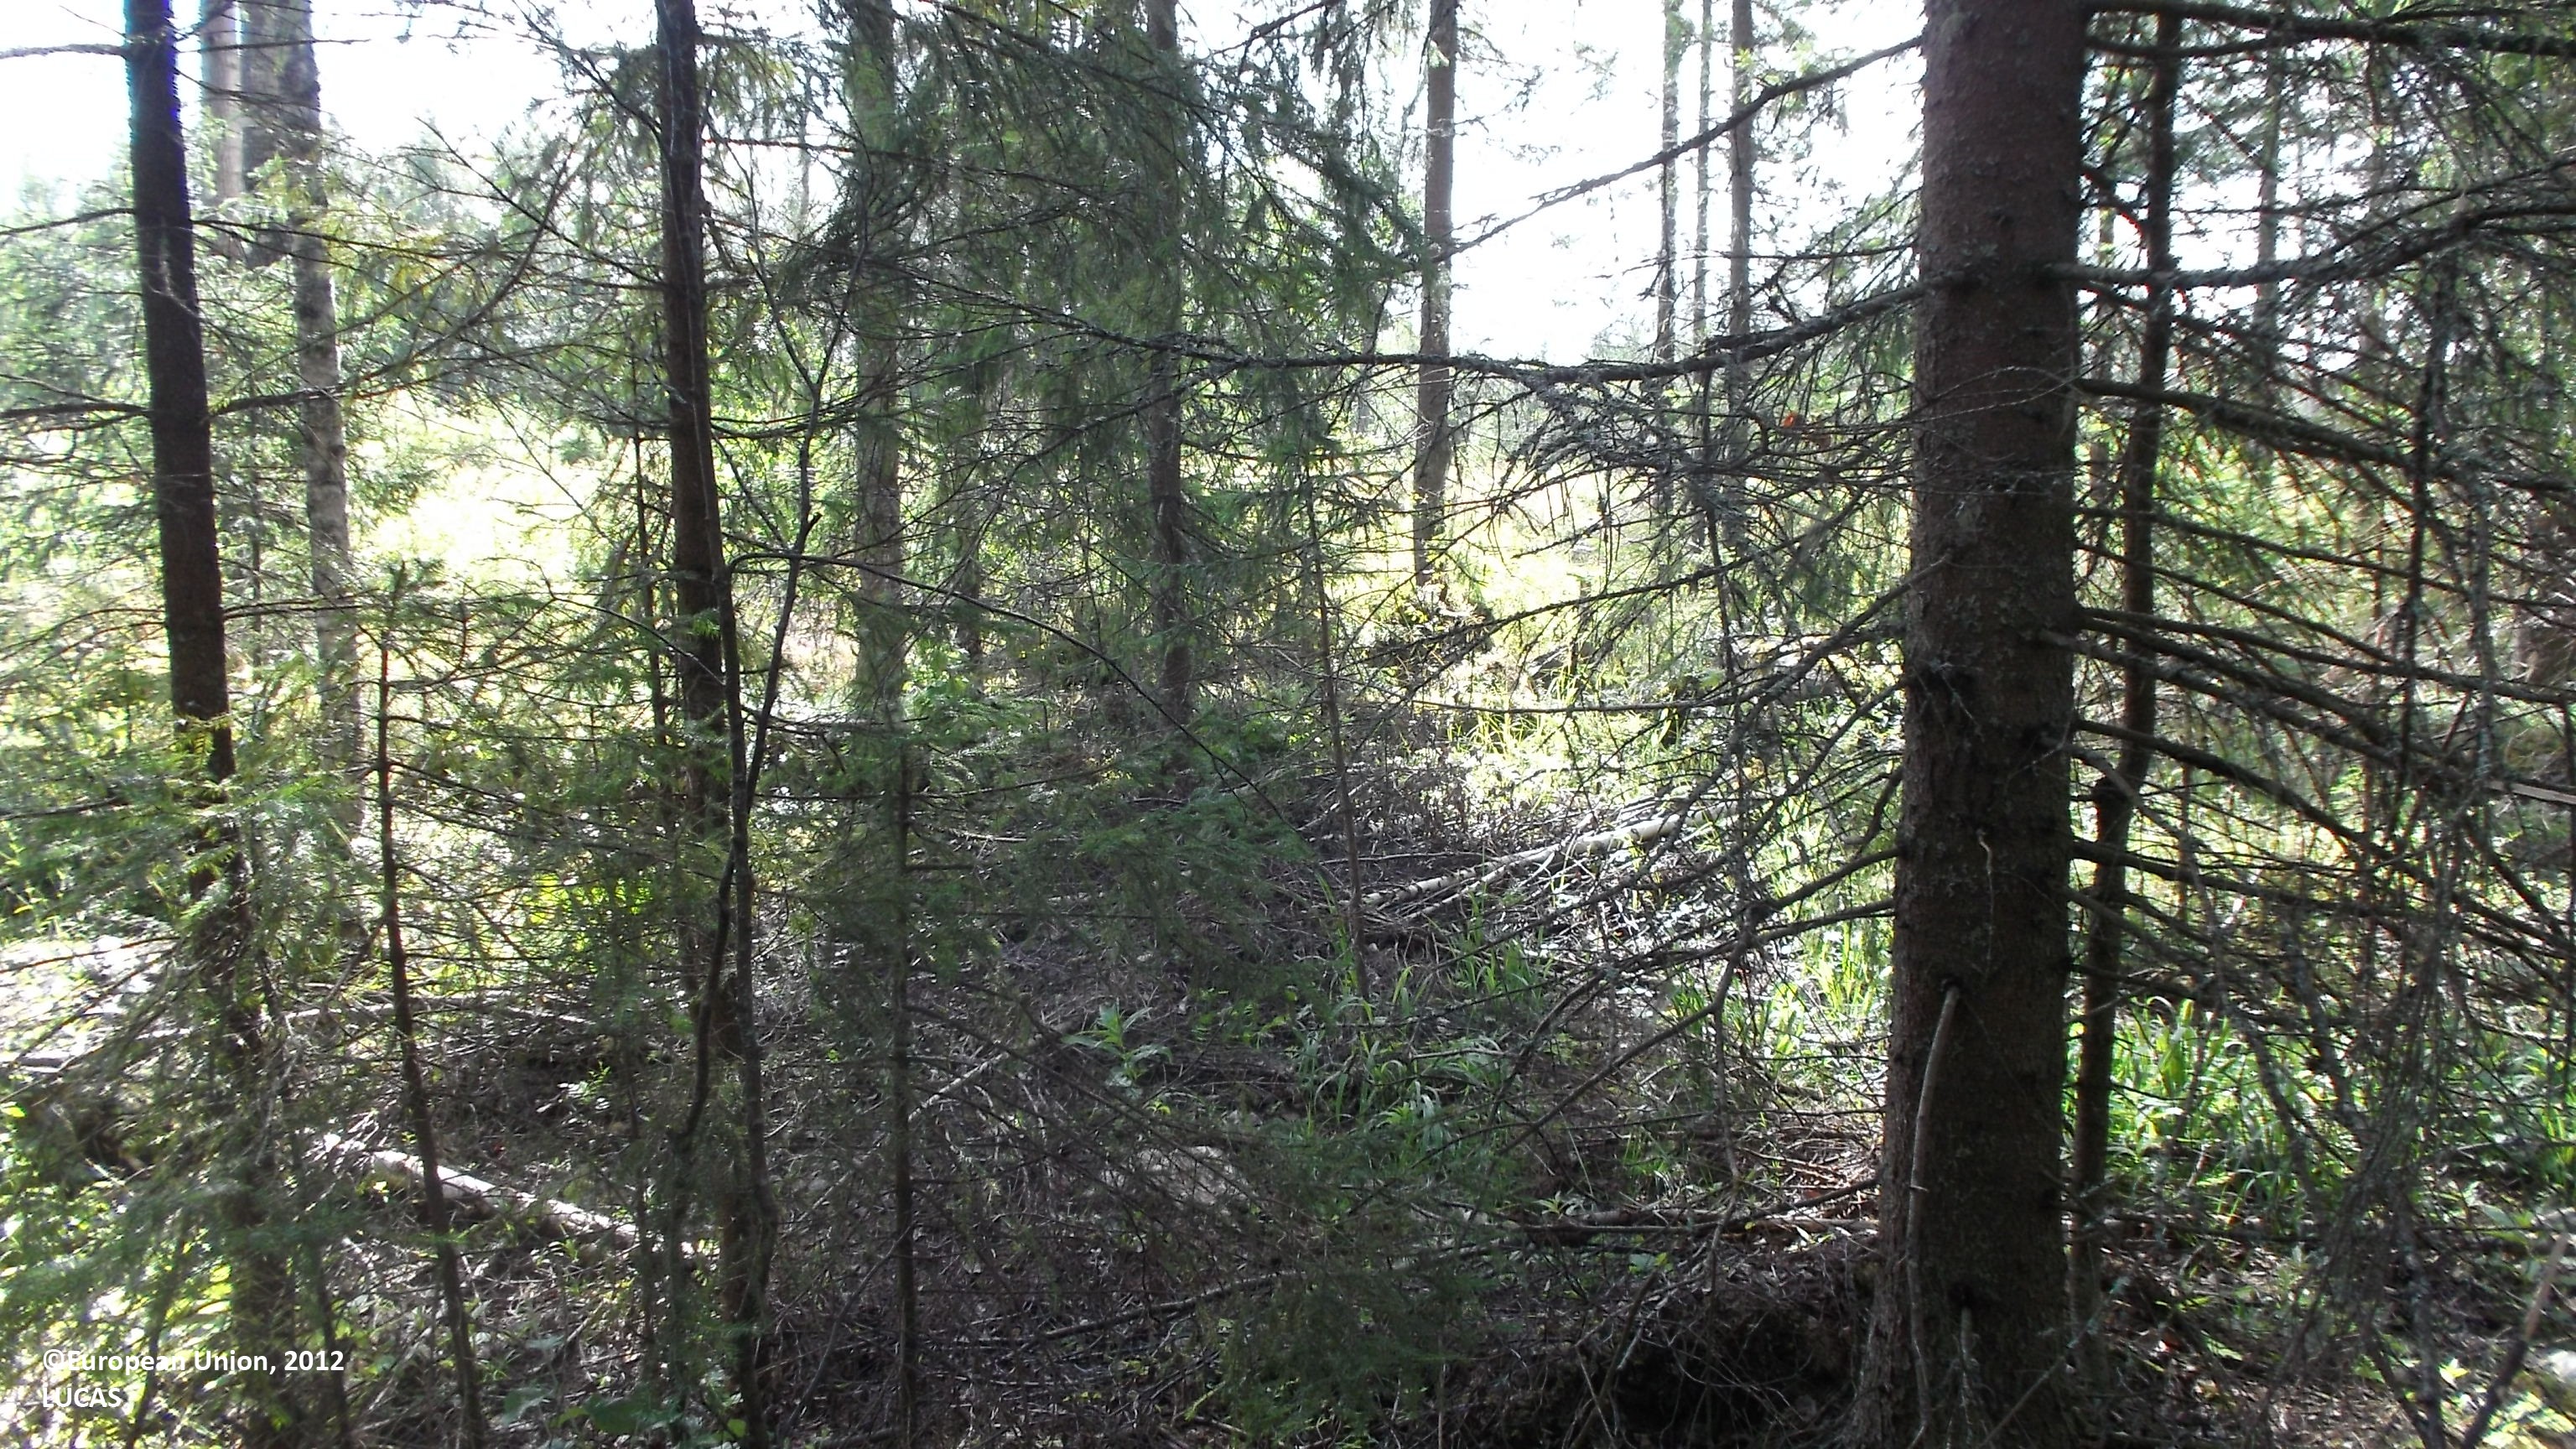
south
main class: Woodland
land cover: Spruce dominated coniferous woodland
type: boreal forest
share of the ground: 50 - 75 %
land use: Forestry
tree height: > 5 m
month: August
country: FI
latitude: 63.9001
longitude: 23.4009
